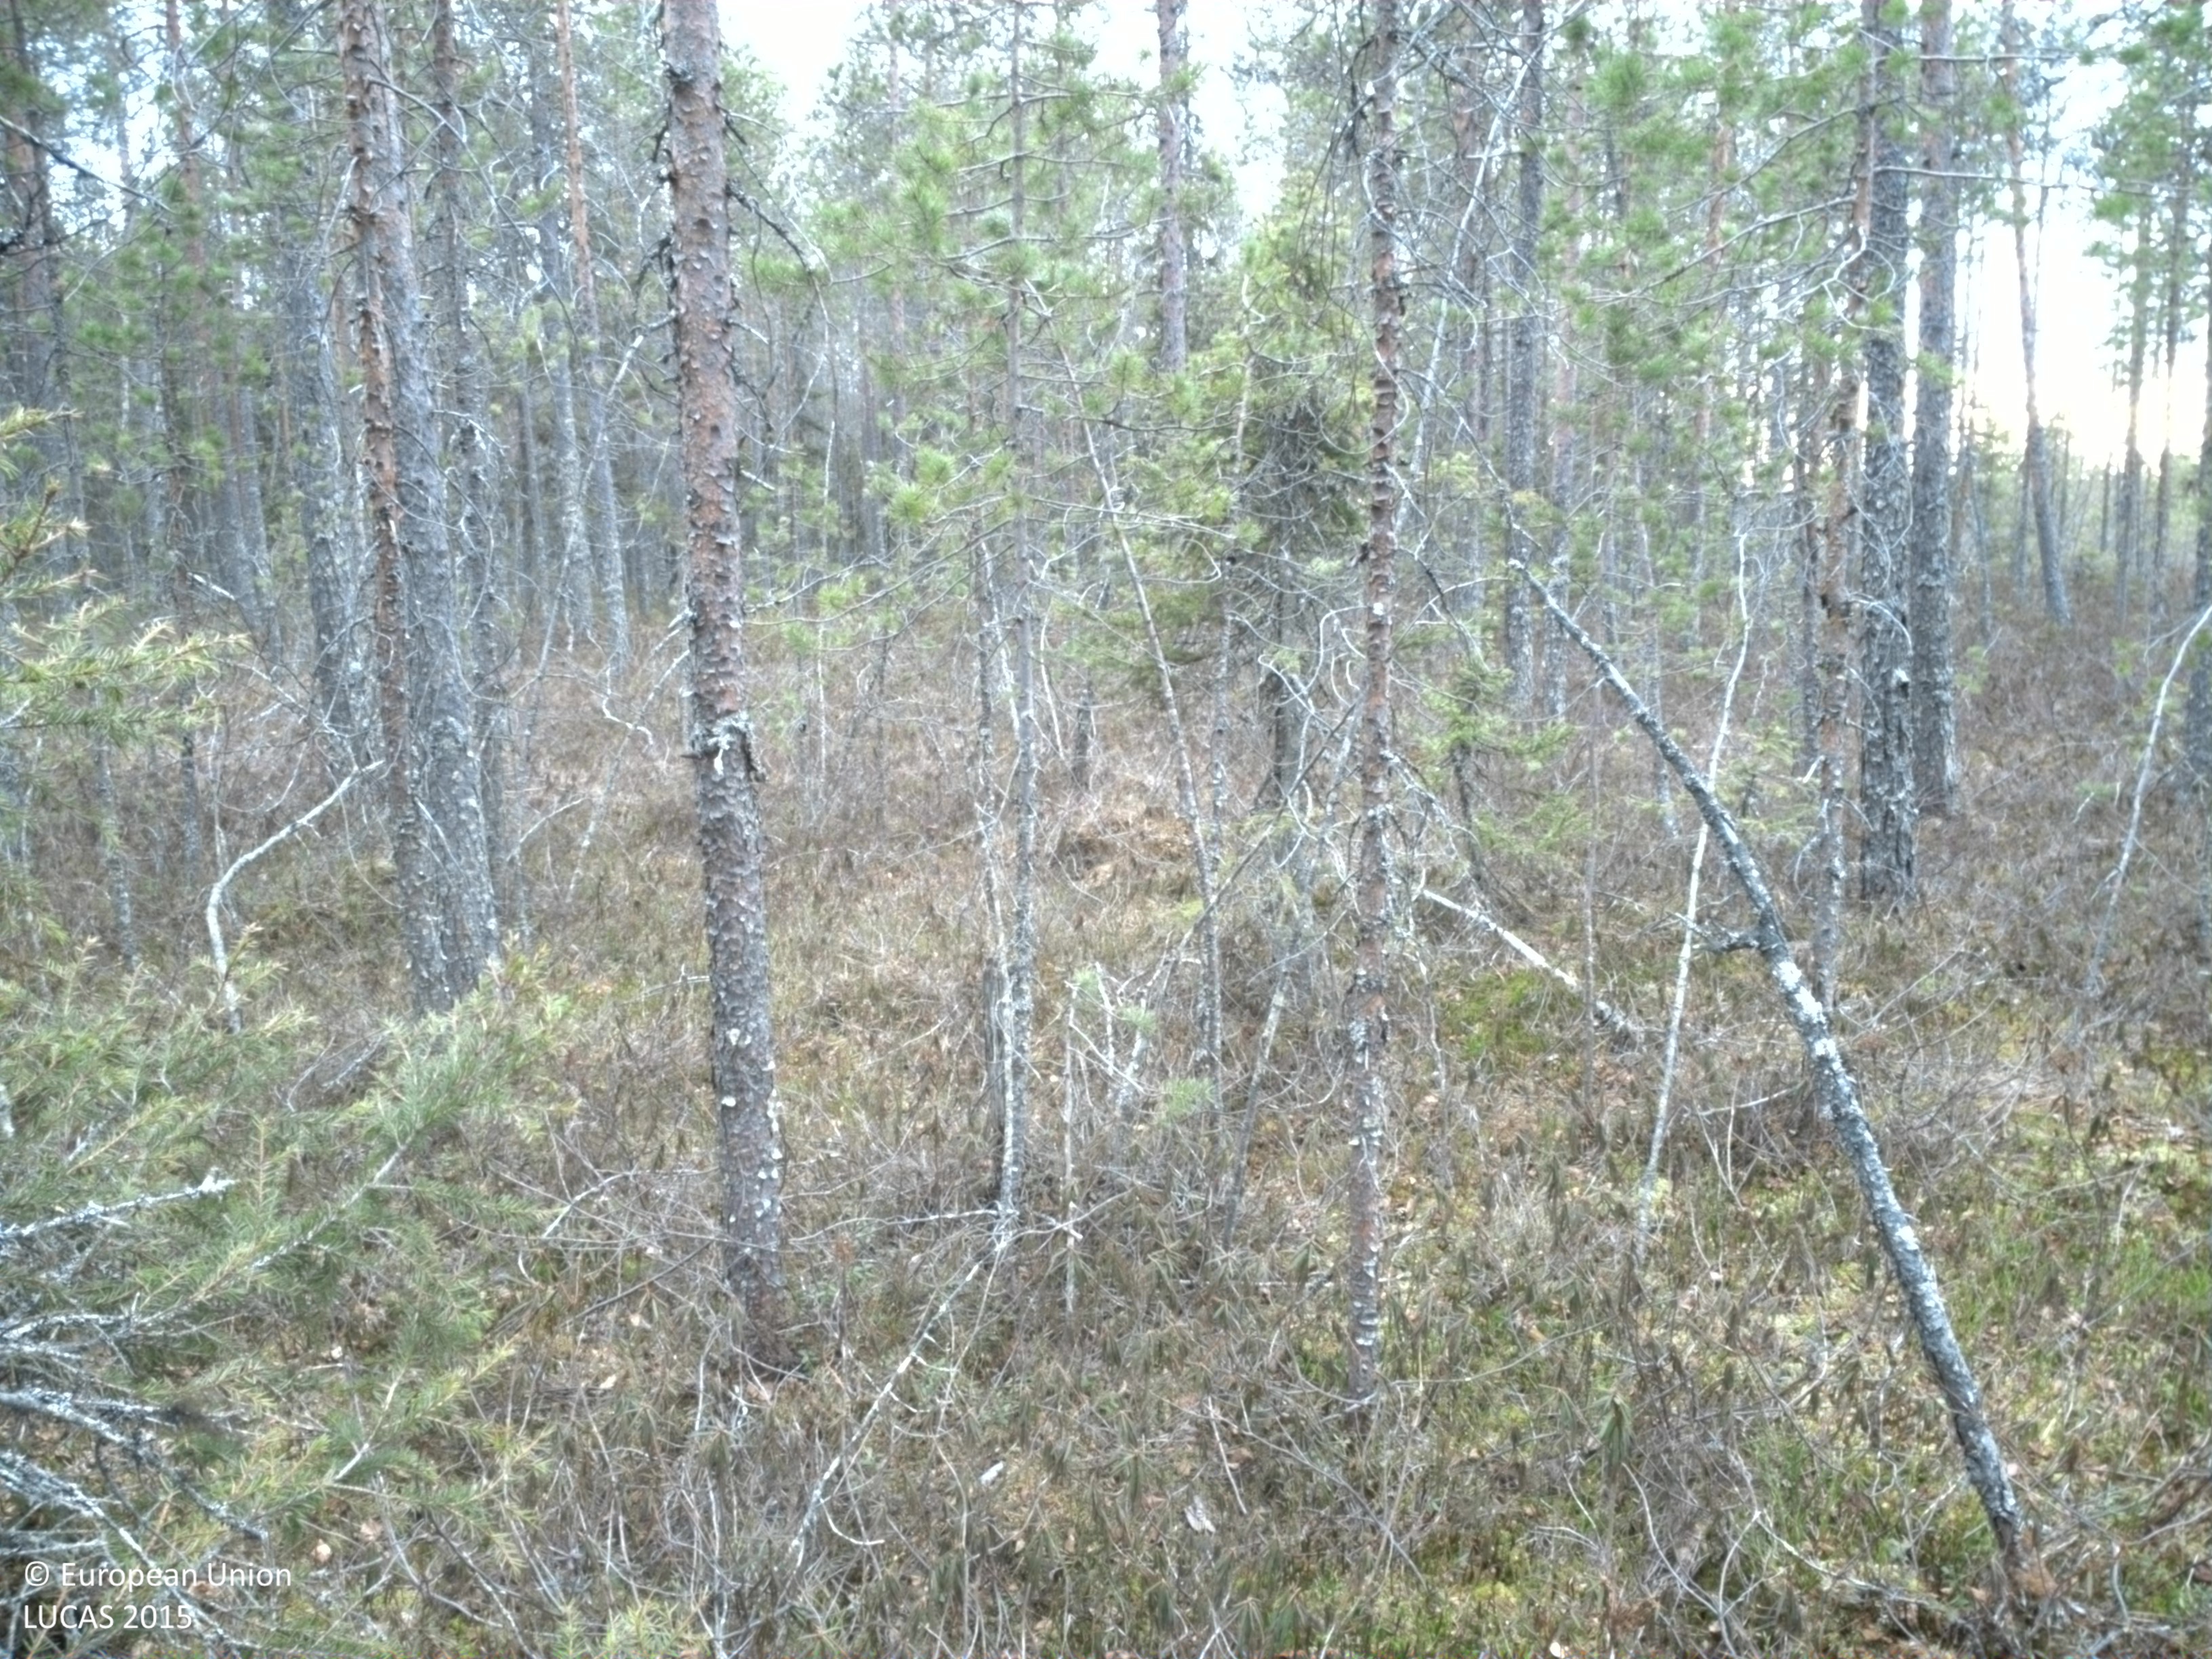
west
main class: Woodland
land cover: Pine dominated coniferous woodland
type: boreal forest
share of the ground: 50 - 75 %
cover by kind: coniferous forest trees 60 %, shrubs 40 %
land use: Forestry
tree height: > 5 m
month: May
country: SE
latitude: 65.8536
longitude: 22.8884
